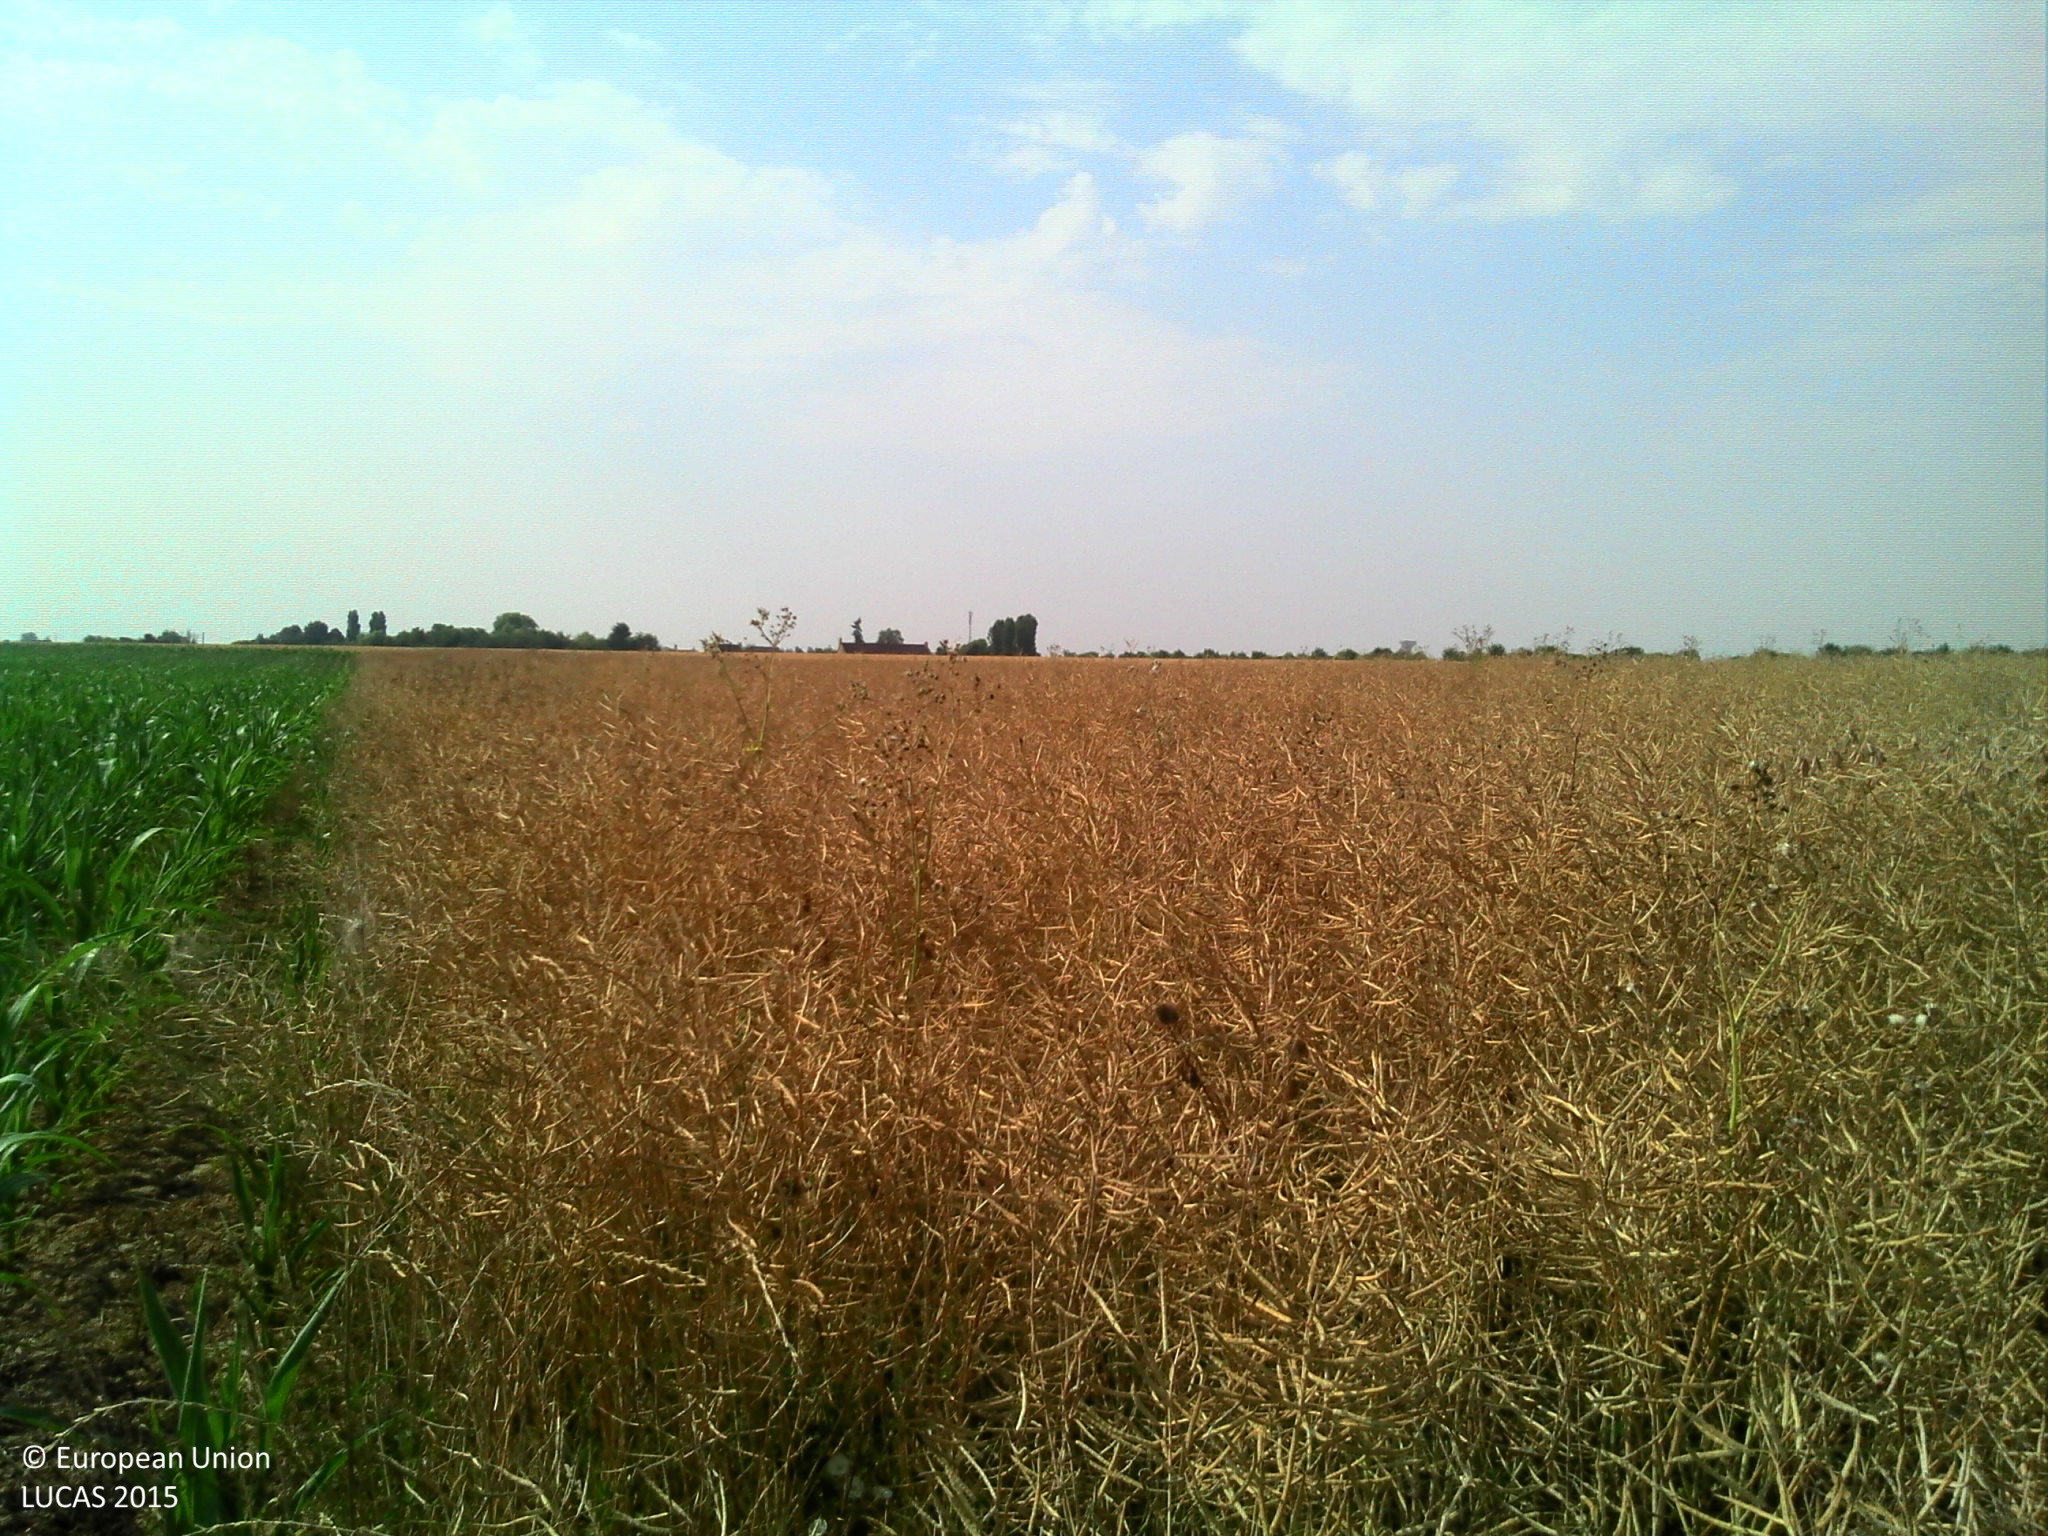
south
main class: Cropland
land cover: Rape and turnip rape
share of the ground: > 75 %
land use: Agriculture (excluding fallow land and kitchen gardens)
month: July
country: FR
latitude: 47.8463
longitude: 2.8434
